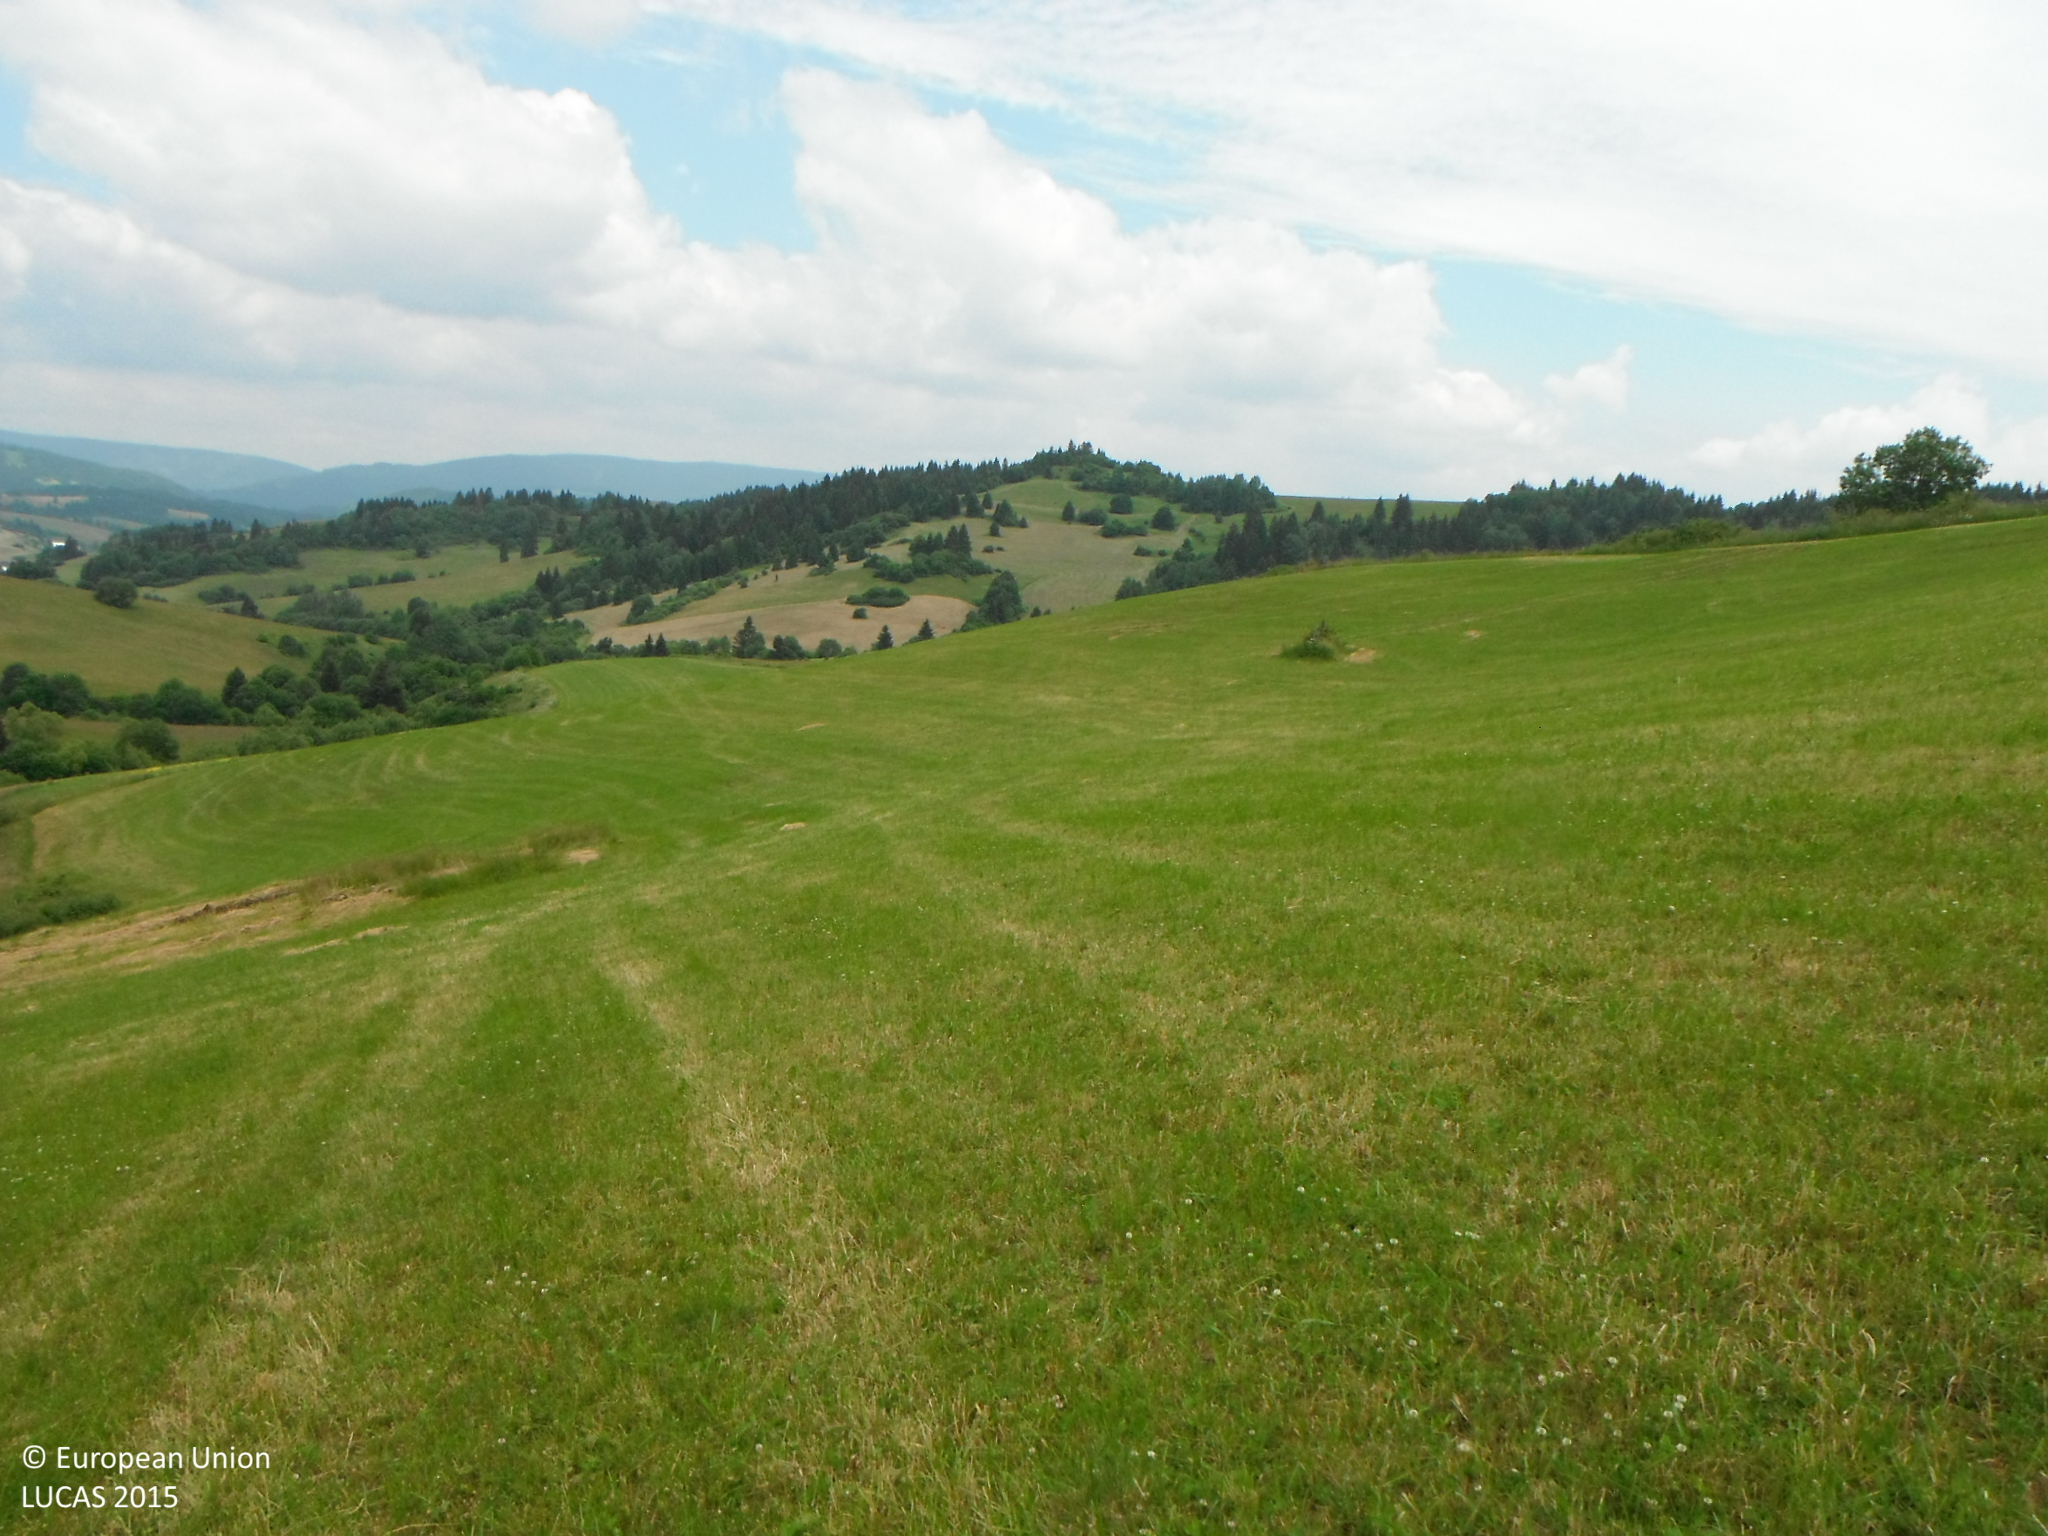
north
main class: Grassland
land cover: Grassland without tree/shrub cover
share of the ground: > 75 %
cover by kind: herbaceous plants 100 %
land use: Agriculture (excluding fallow land and kitchen gardens)
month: June
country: SK
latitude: 49.1954
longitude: 19.4257
